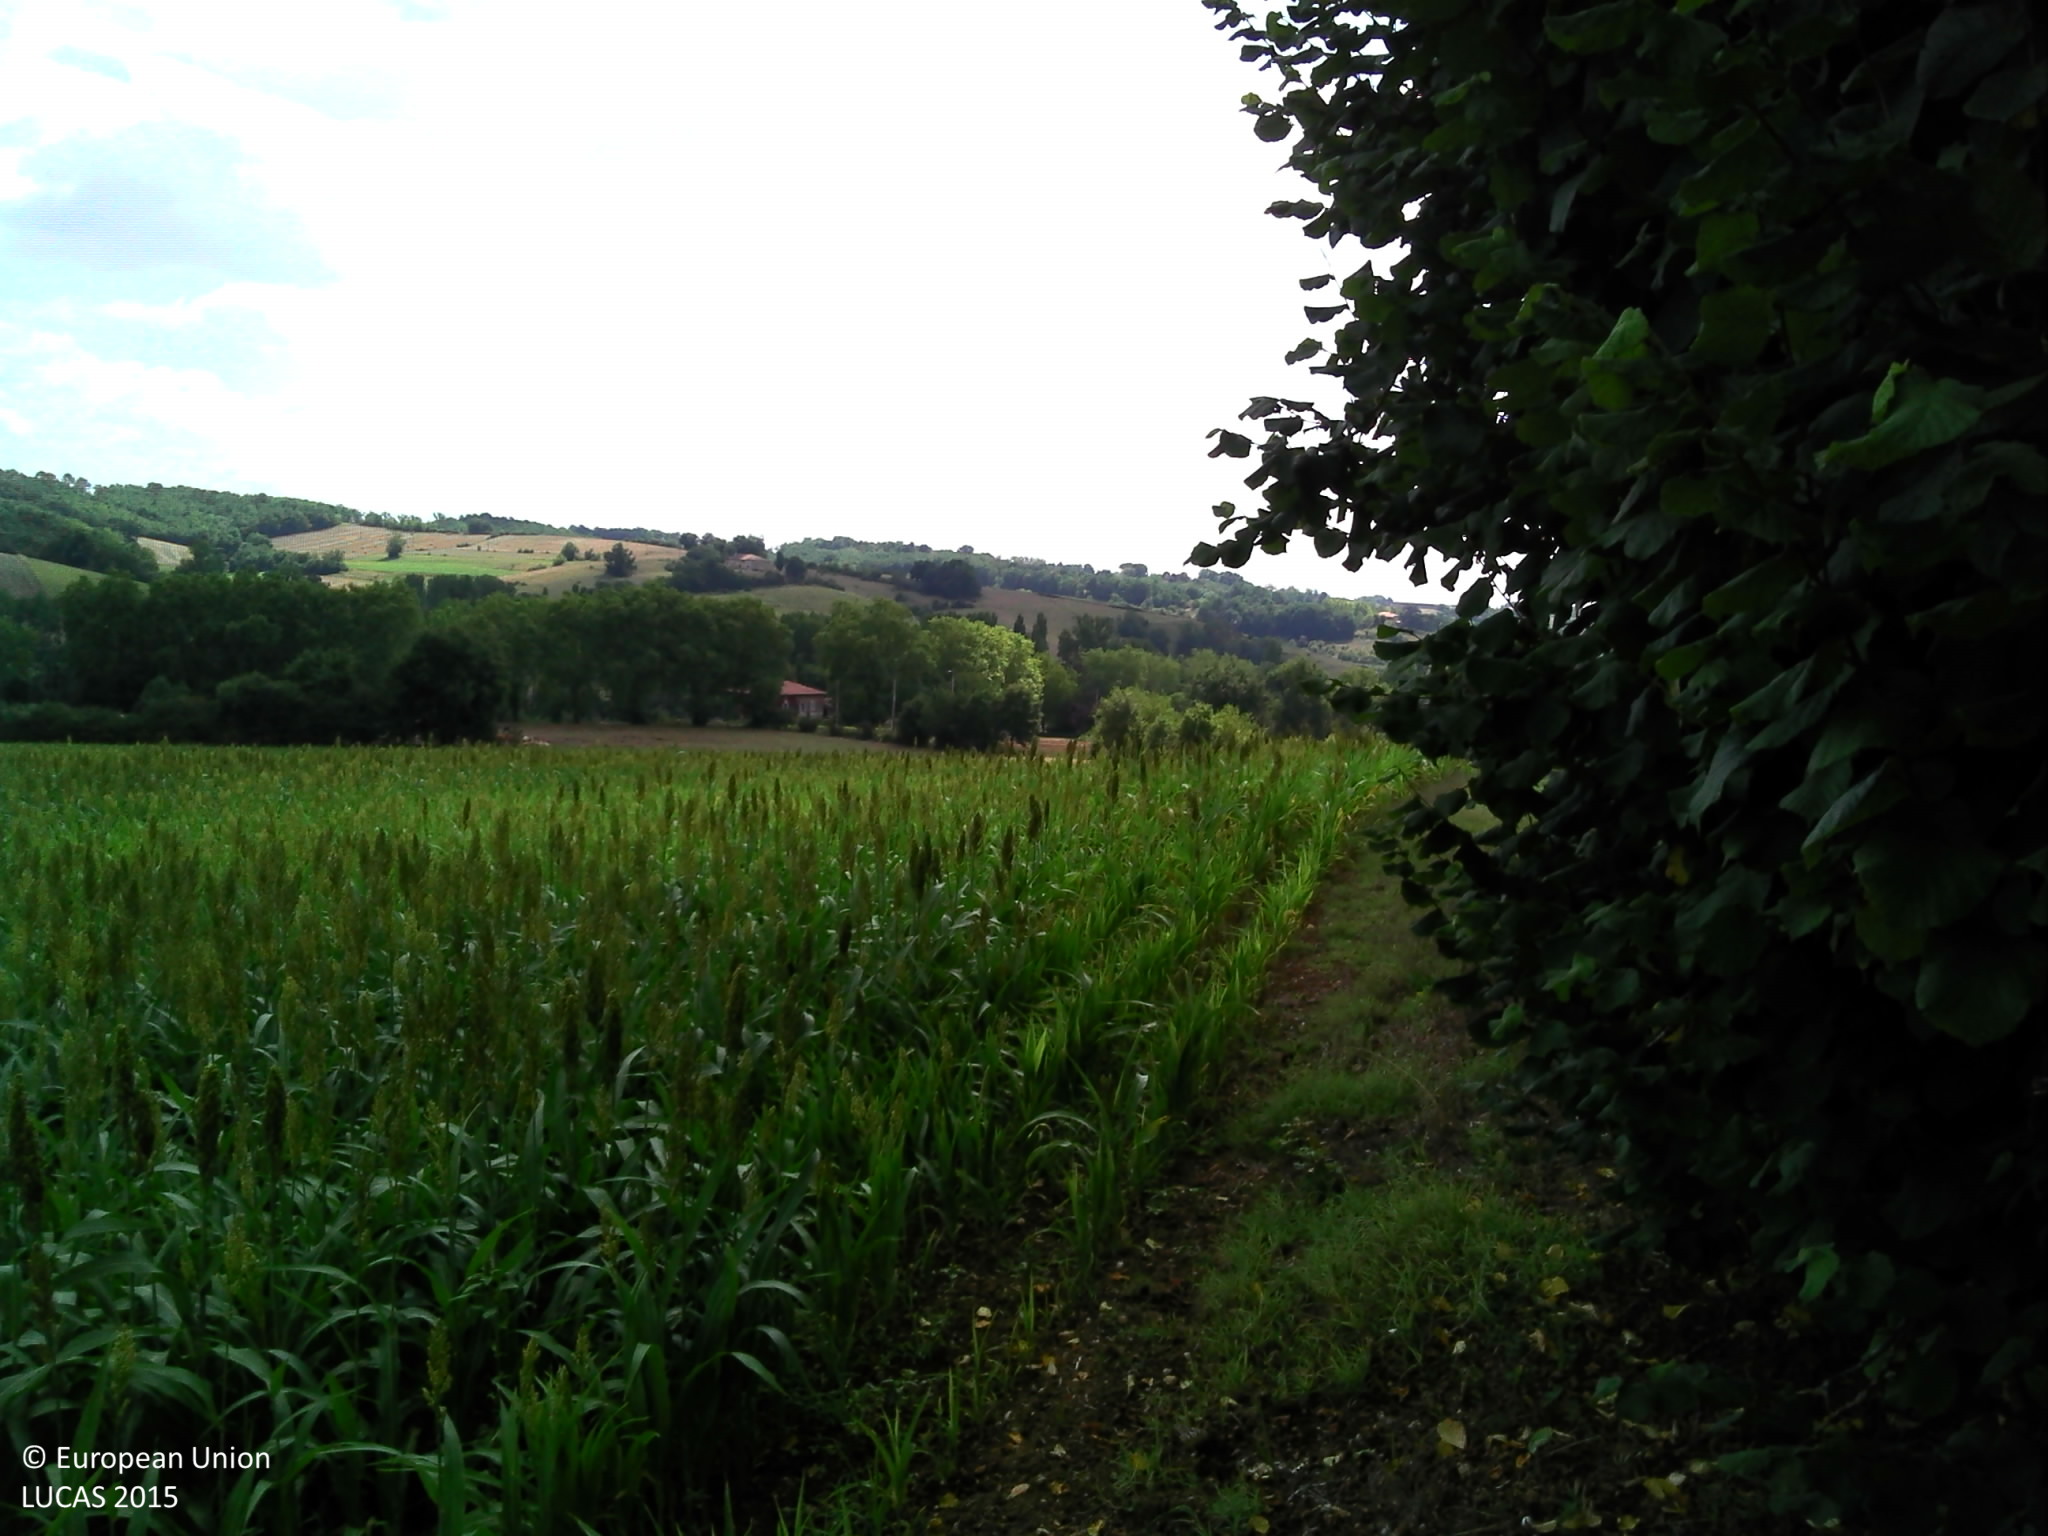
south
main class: Grassland
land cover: Grassland with sparse tree/shrub cover
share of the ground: > 75 %
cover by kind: herbaceous plants 95 %, broadleaved forest trees 5 %
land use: Residential
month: August
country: FR
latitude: 43.9682
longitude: 1.5379
